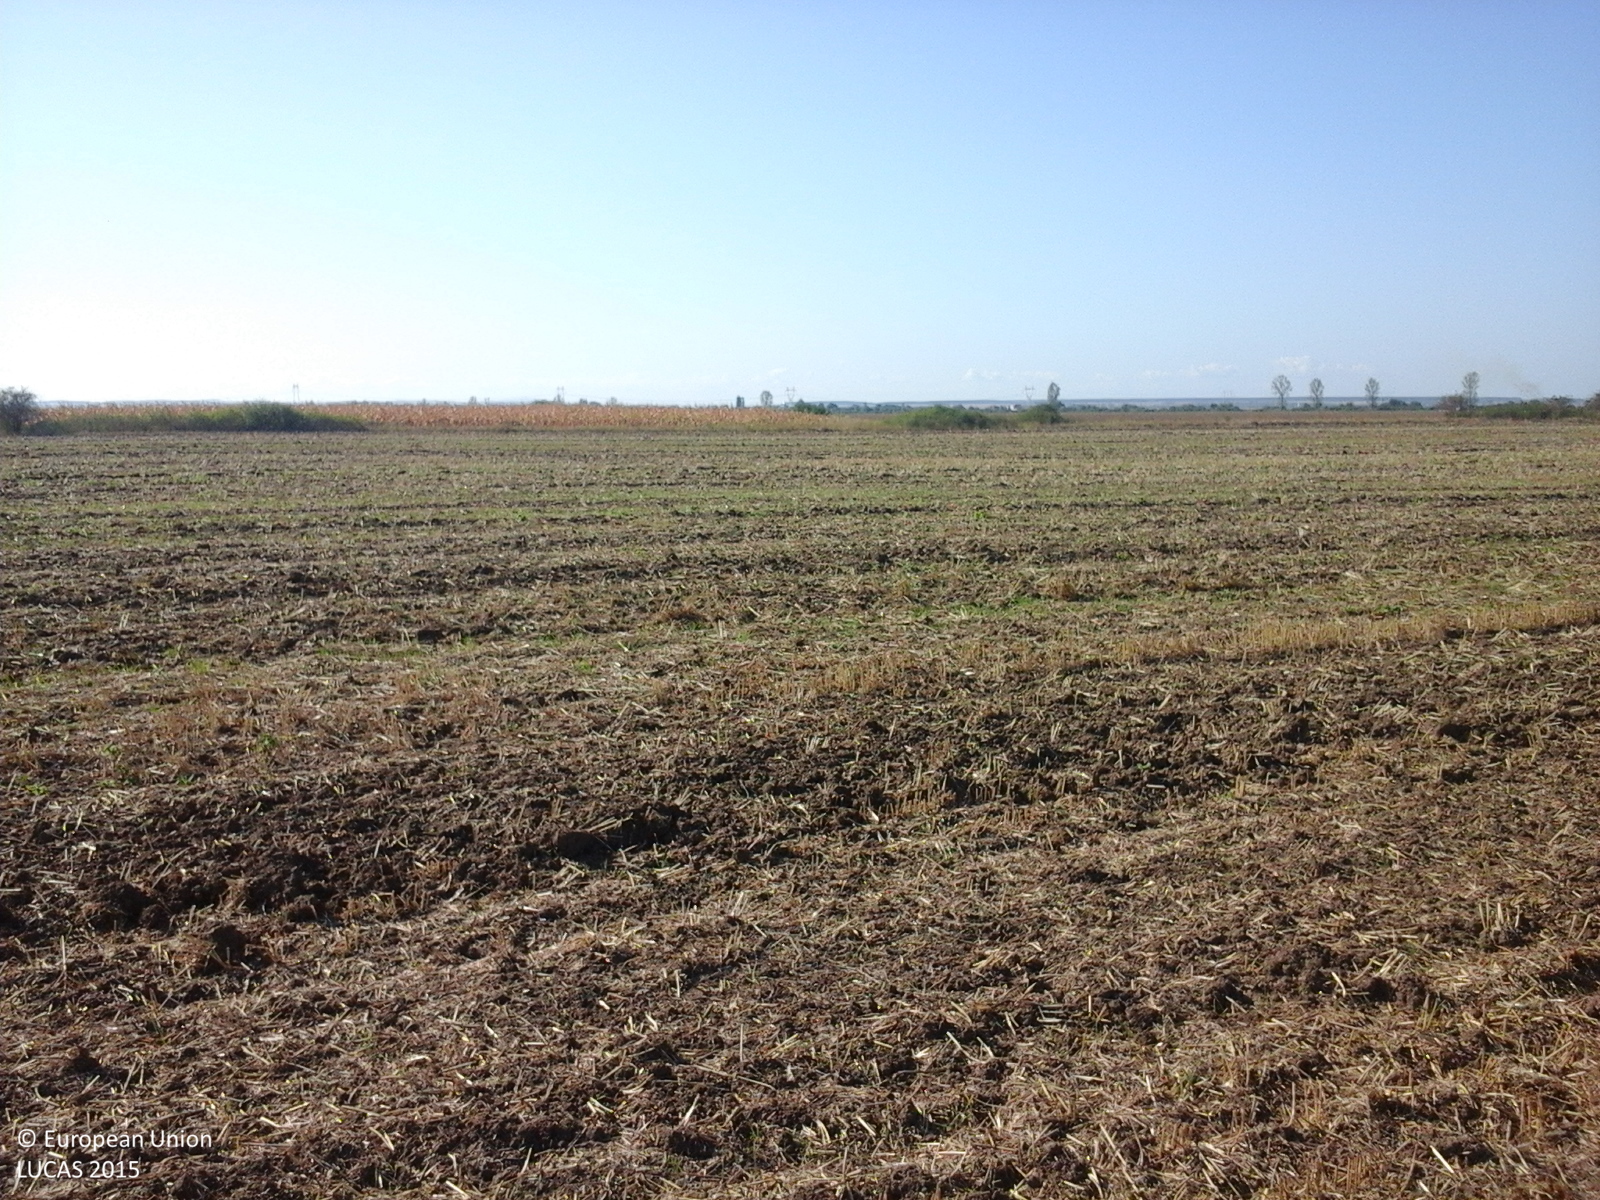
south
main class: Cropland
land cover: Common wheat
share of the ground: 25 - 50 %
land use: Agriculture (excluding fallow land and kitchen gardens)
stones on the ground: < 10 %
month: September
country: RO
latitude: 47.5669
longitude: 22.7823
